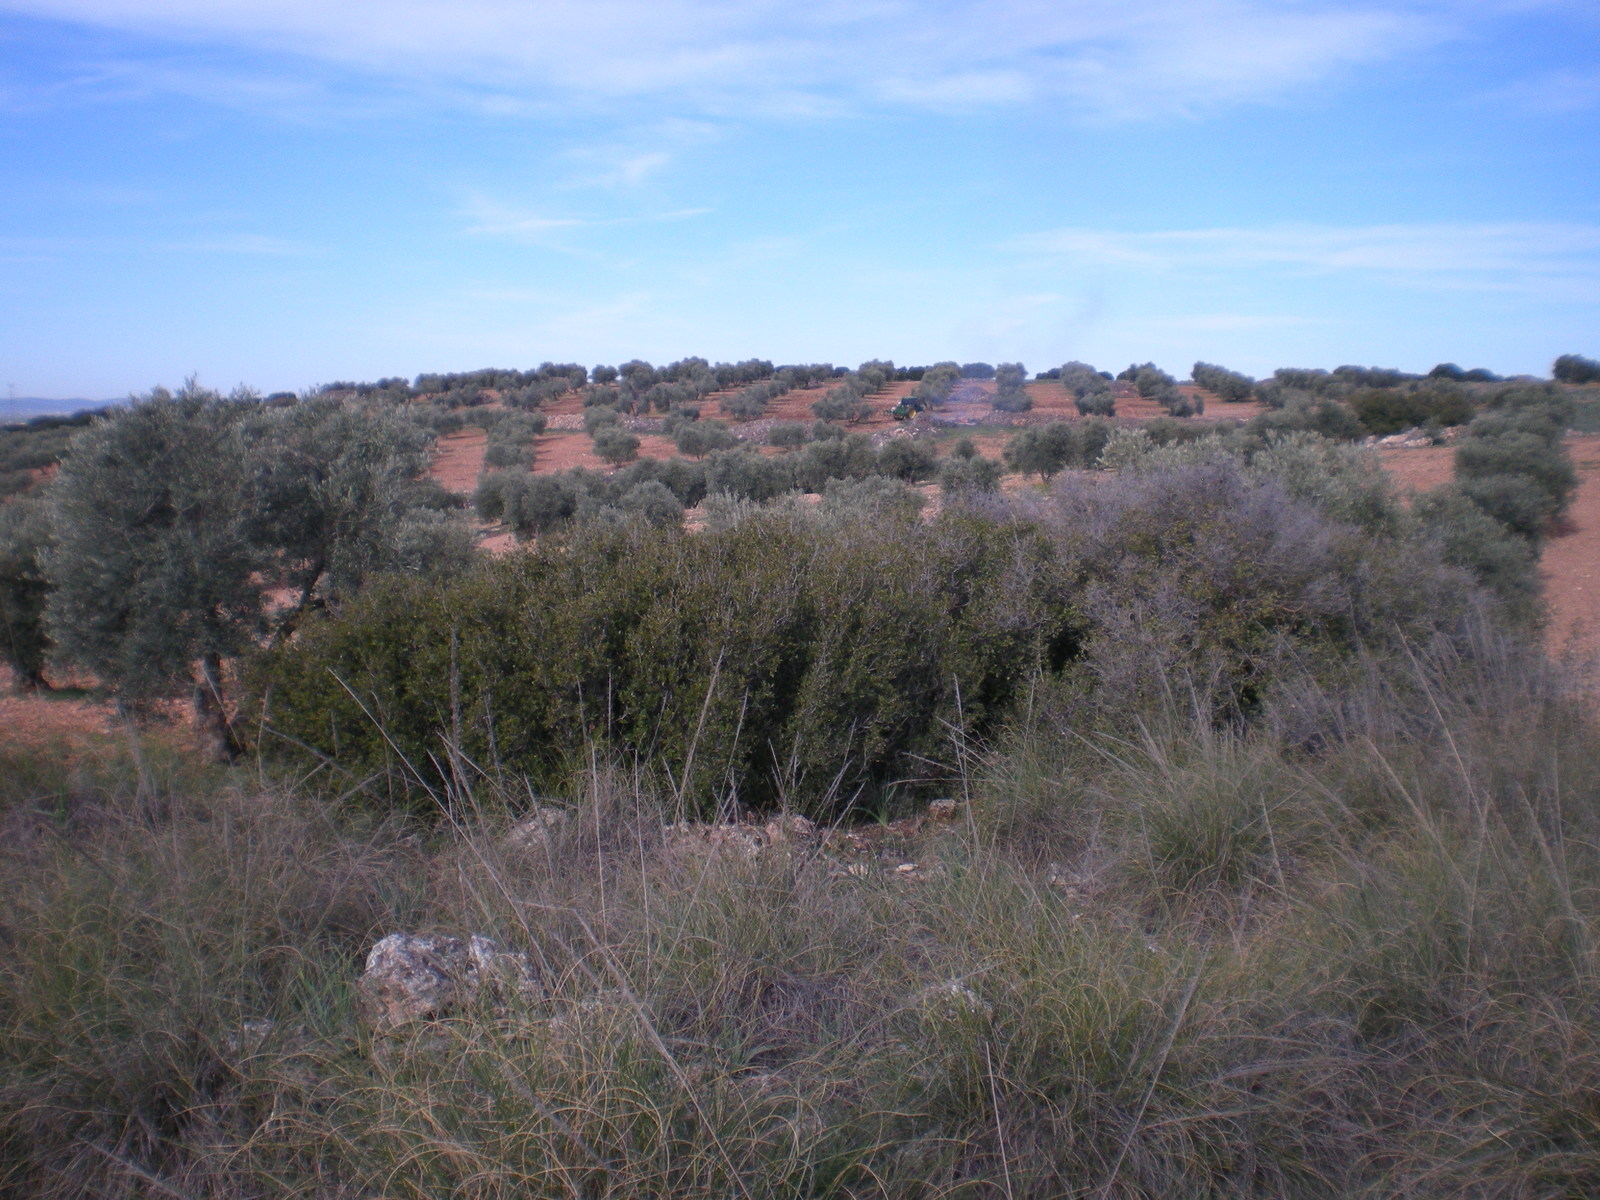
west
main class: Shrubland
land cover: Shrubland with sparse tree cover
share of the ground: 50 - 75 %
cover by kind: shrubs 50 %, herbaceous plants 45 %, broadleaved forest trees 5 %
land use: Semi-natural and natural areas not in use
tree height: < 5 m
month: March
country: ES
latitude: 38.9761
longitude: -3.2755
